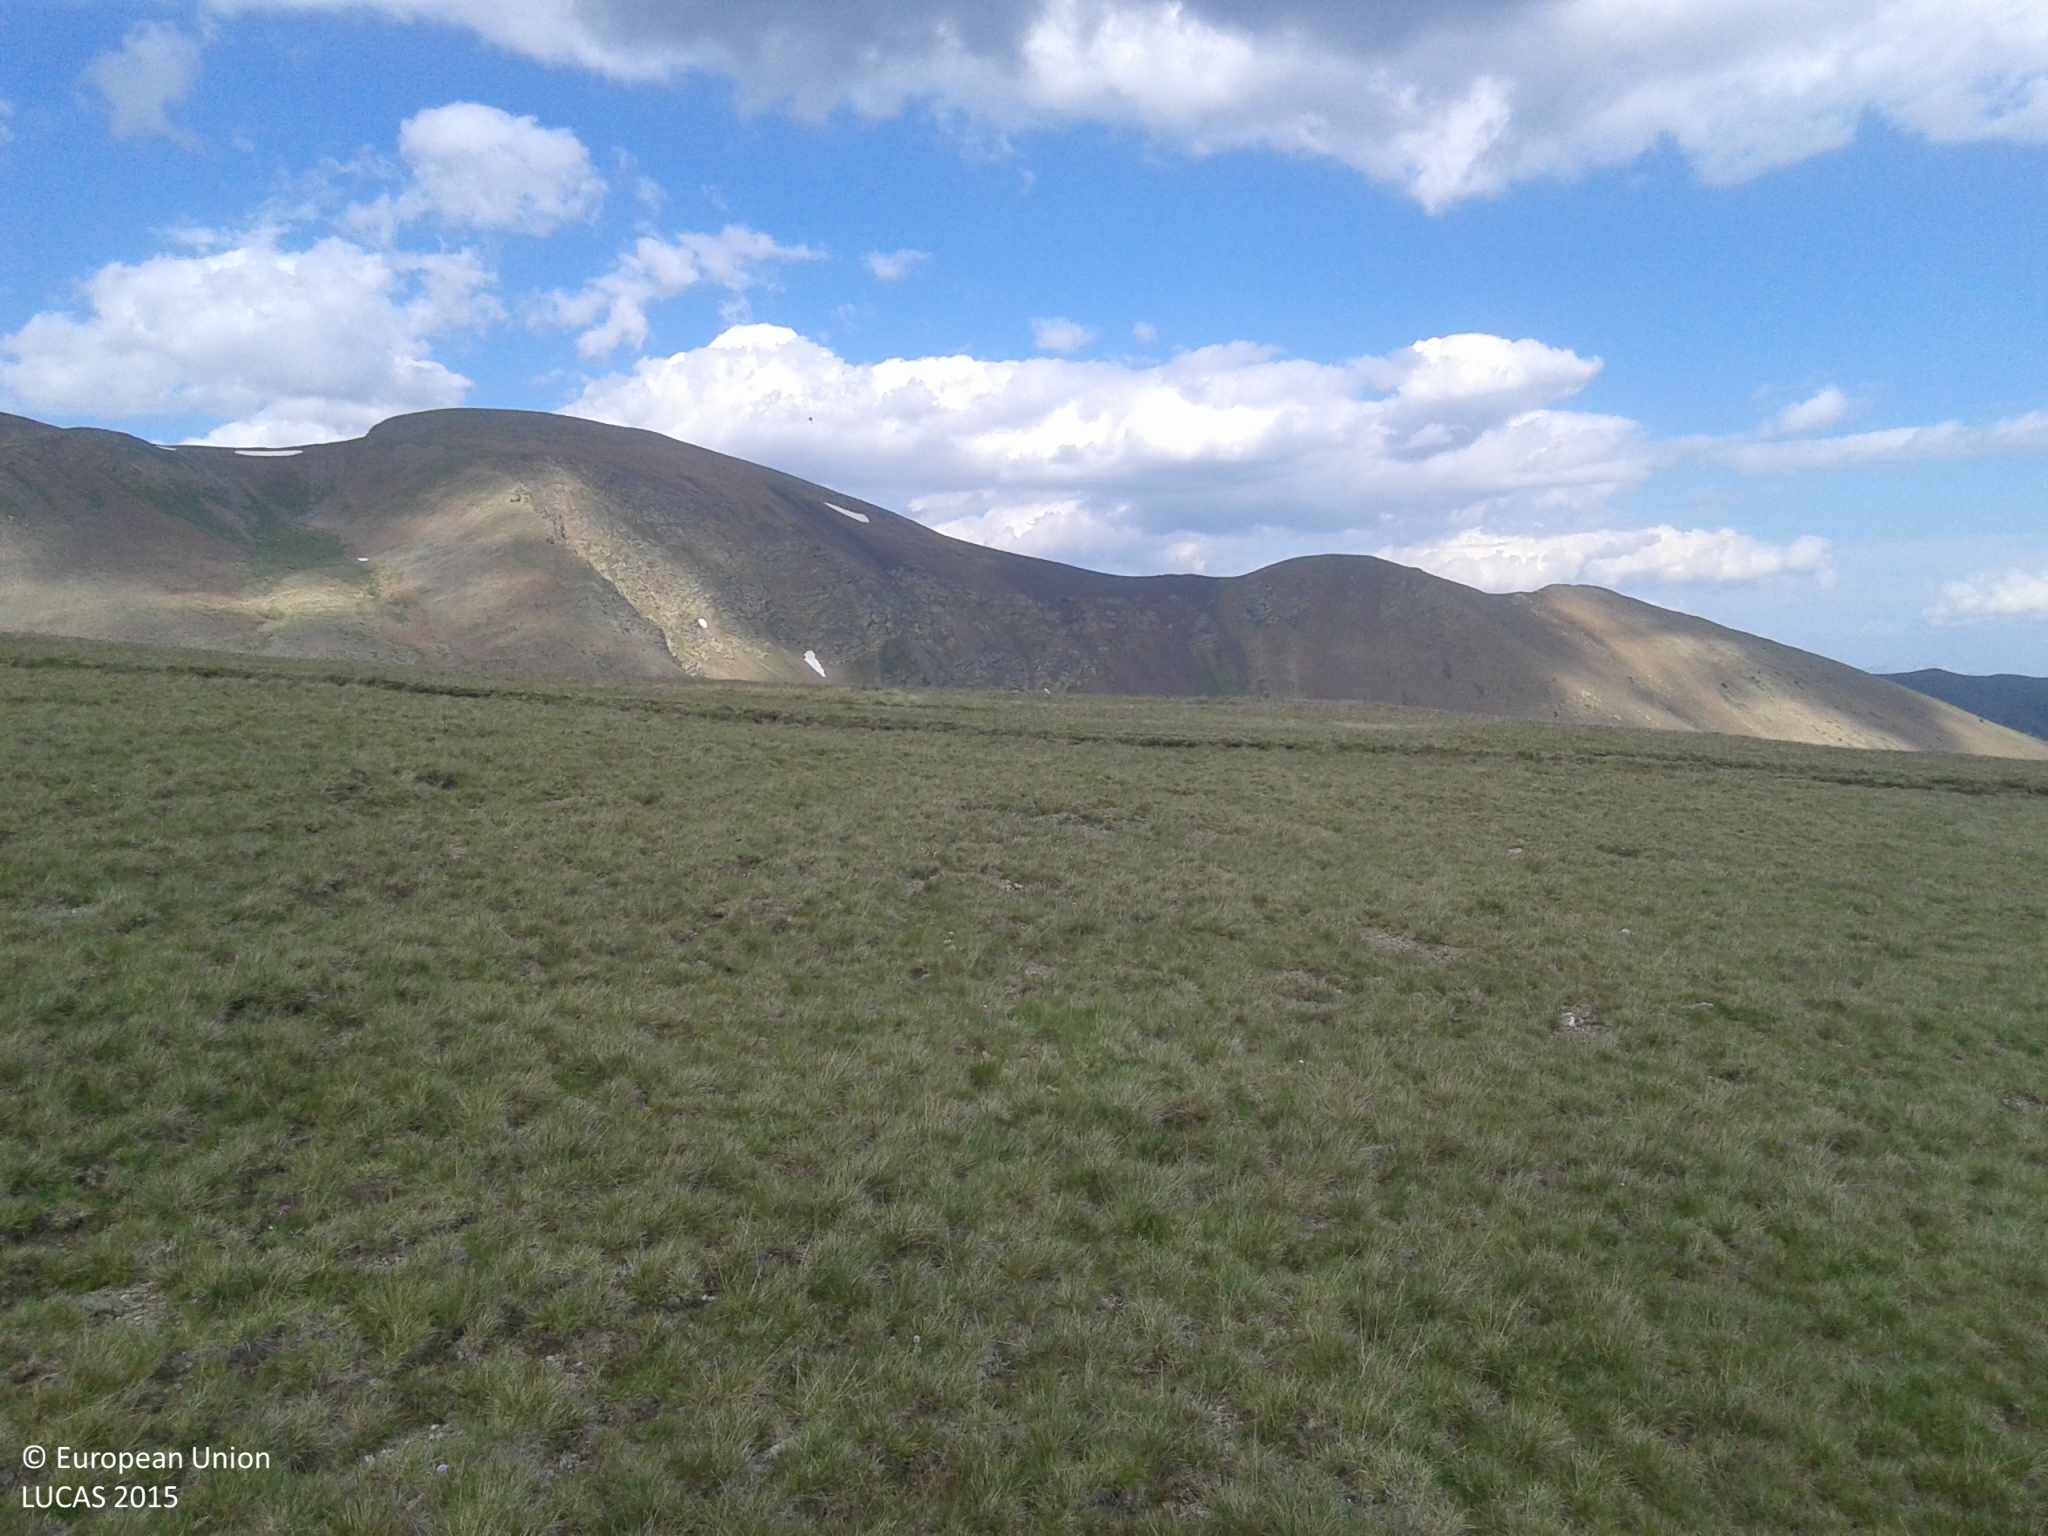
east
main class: Grassland
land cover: Grassland without tree/shrub cover
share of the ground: > 75 %
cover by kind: herbaceous plants 90 %, consolidated bare surface 10 %
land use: Agriculture (excluding fallow land and kitchen gardens)
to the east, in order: Grassland without tree/shrub cover; Tracks; Grassland without tree/shrub cover; Tracks; Grassland without tree/shrub cover
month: June
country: ES
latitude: 42.4464
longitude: 1.5599
